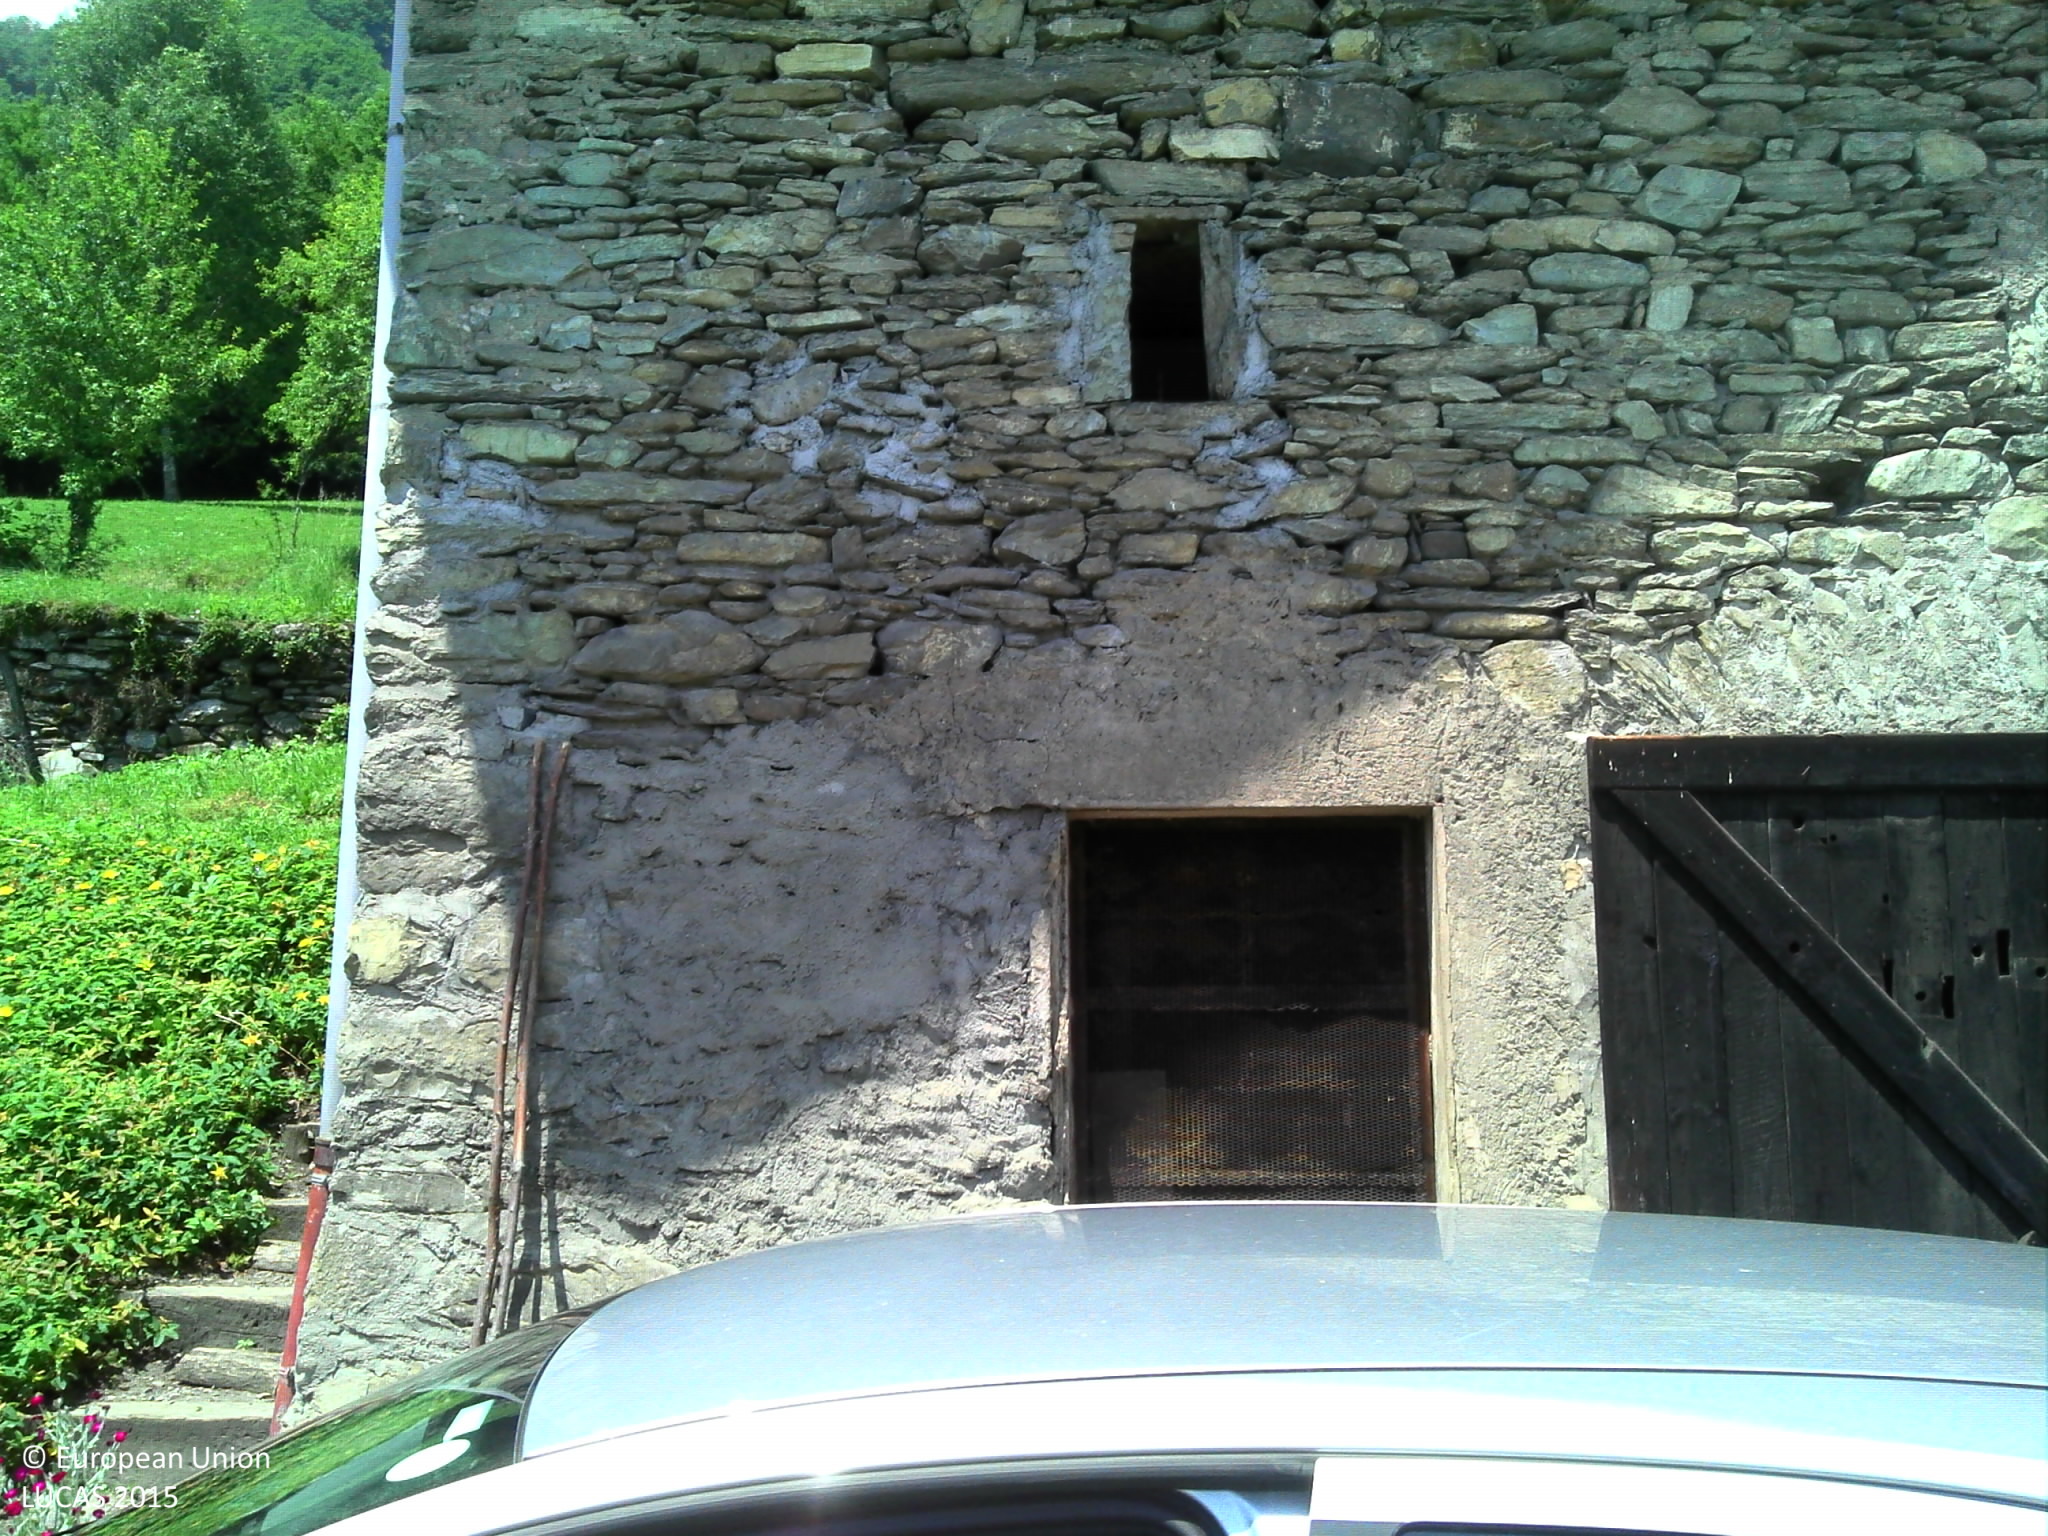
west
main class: Woodland
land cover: Broadleaved woodland
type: mountainous beech forest
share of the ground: > 75 %
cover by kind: broadleaved forest trees 100 %
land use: Forestry
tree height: > 5 m
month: June
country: FR
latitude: 45.5992
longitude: 6.2225
